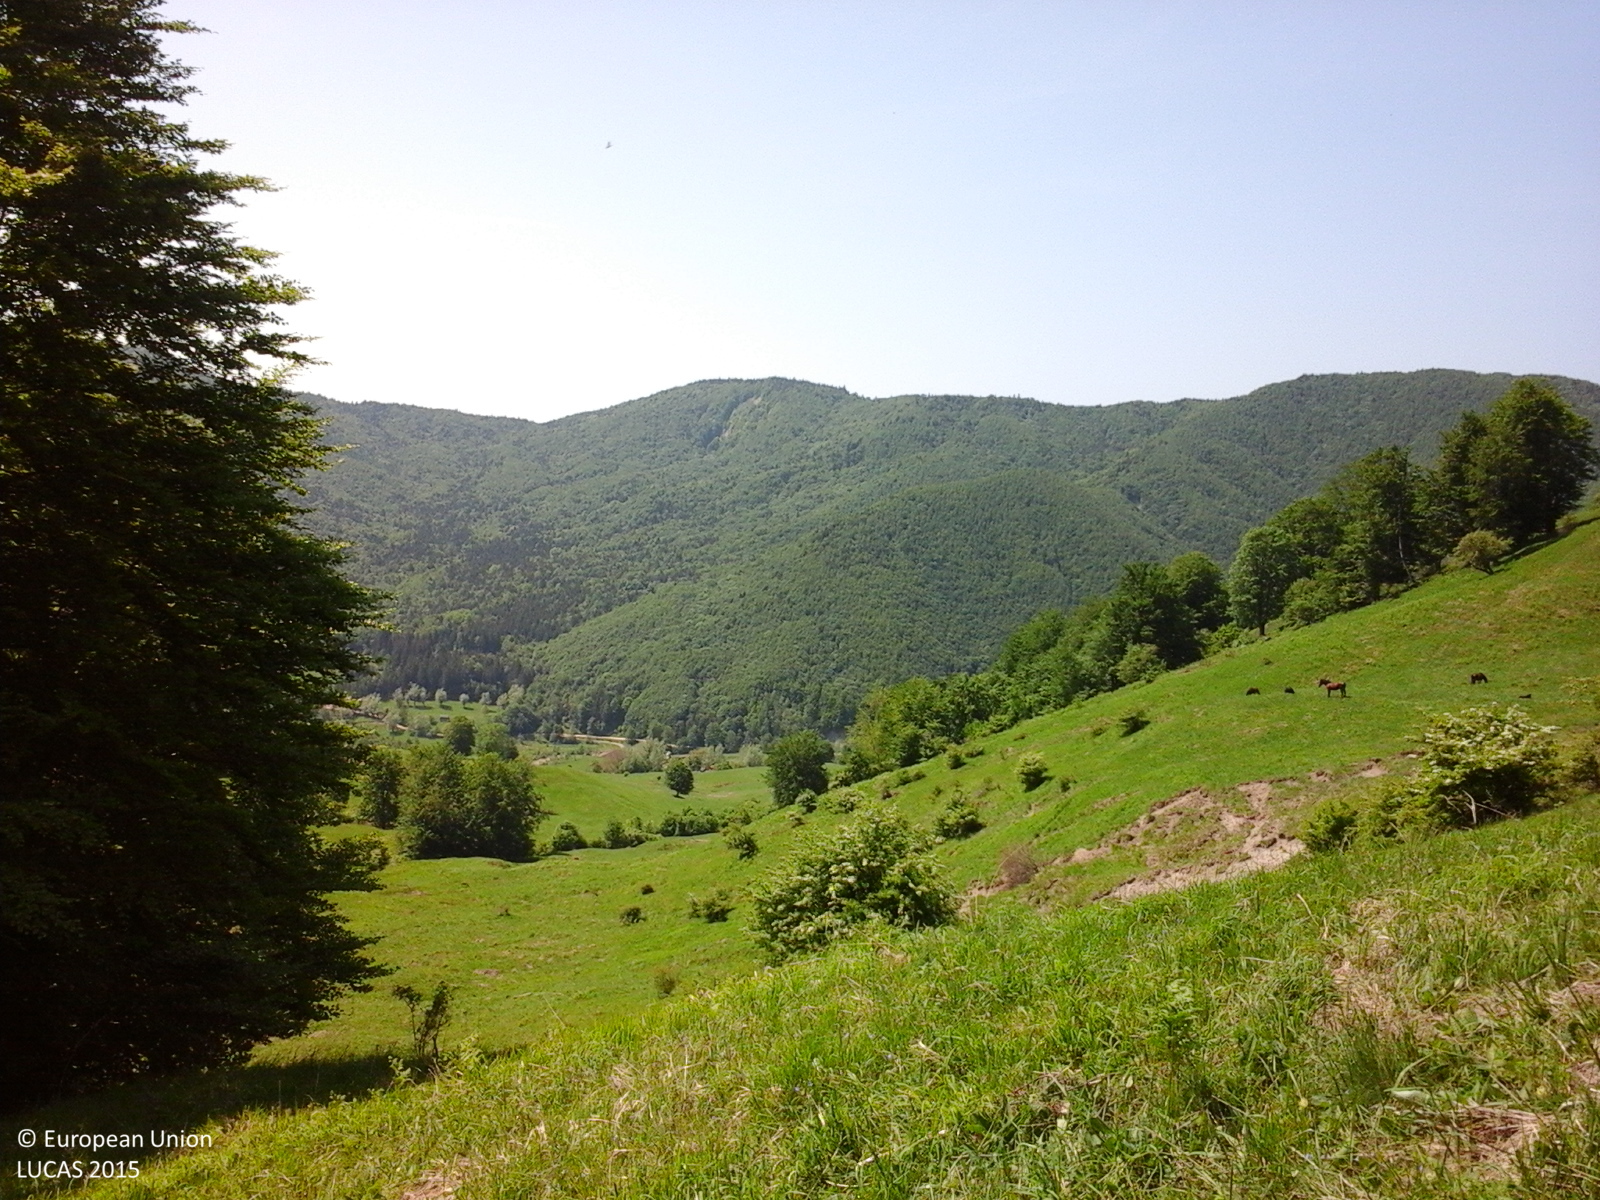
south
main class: Grassland
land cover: Grassland with sparse tree/shrub cover
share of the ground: > 75 %
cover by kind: herbaceous plants 85 %, shrubs 10 %, broadleaved forest trees 5 %
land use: Agriculture (excluding fallow land and kitchen gardens)
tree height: > 5 m
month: May
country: RO
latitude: 45.4306
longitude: 26.2361
